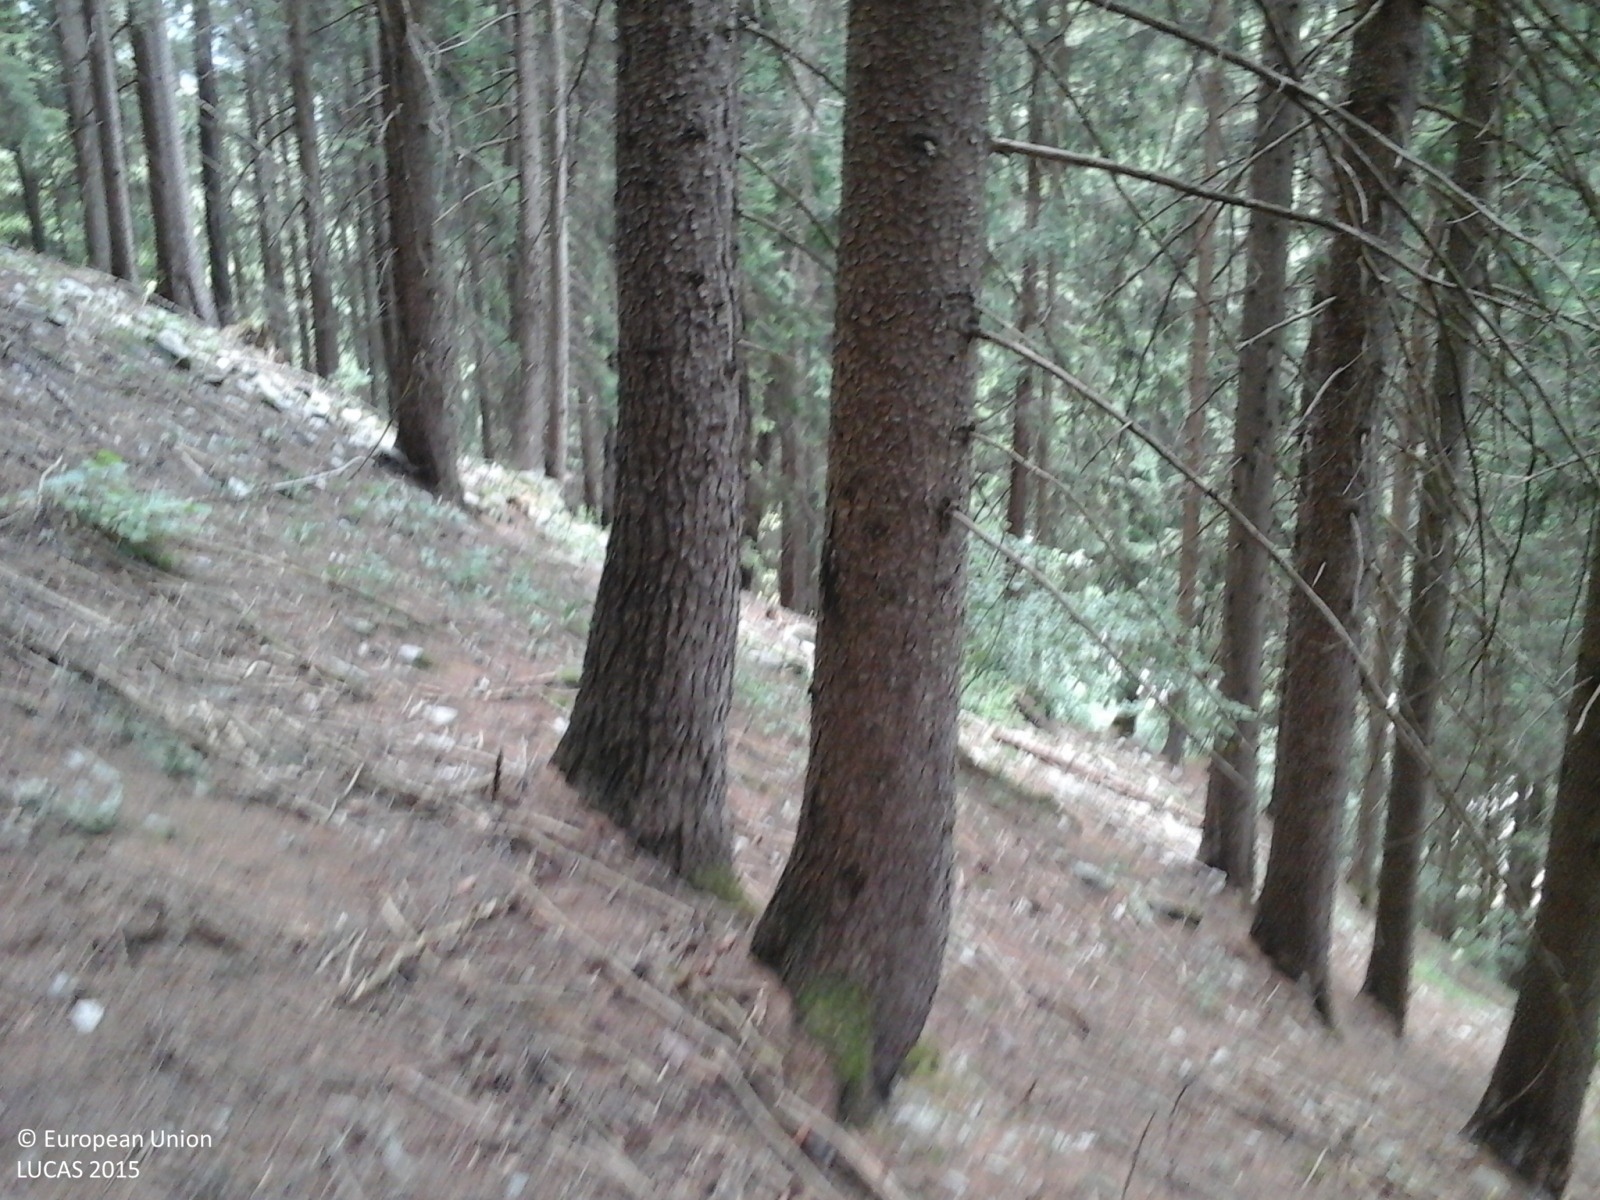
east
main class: Woodland
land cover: Spruce dominated coniferous woodland
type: alpine coniferous forest
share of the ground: > 75 %
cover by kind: coniferous forest trees 100 %
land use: Forestry
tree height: > 5 m
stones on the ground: 10 - 25 %
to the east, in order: Spruce dominated coniferous woodland; Tracks; Spruce dominated coniferous woodland; Grassland without tree/shrub cover
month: June
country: IT
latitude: 46.9993
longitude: 11.9839
